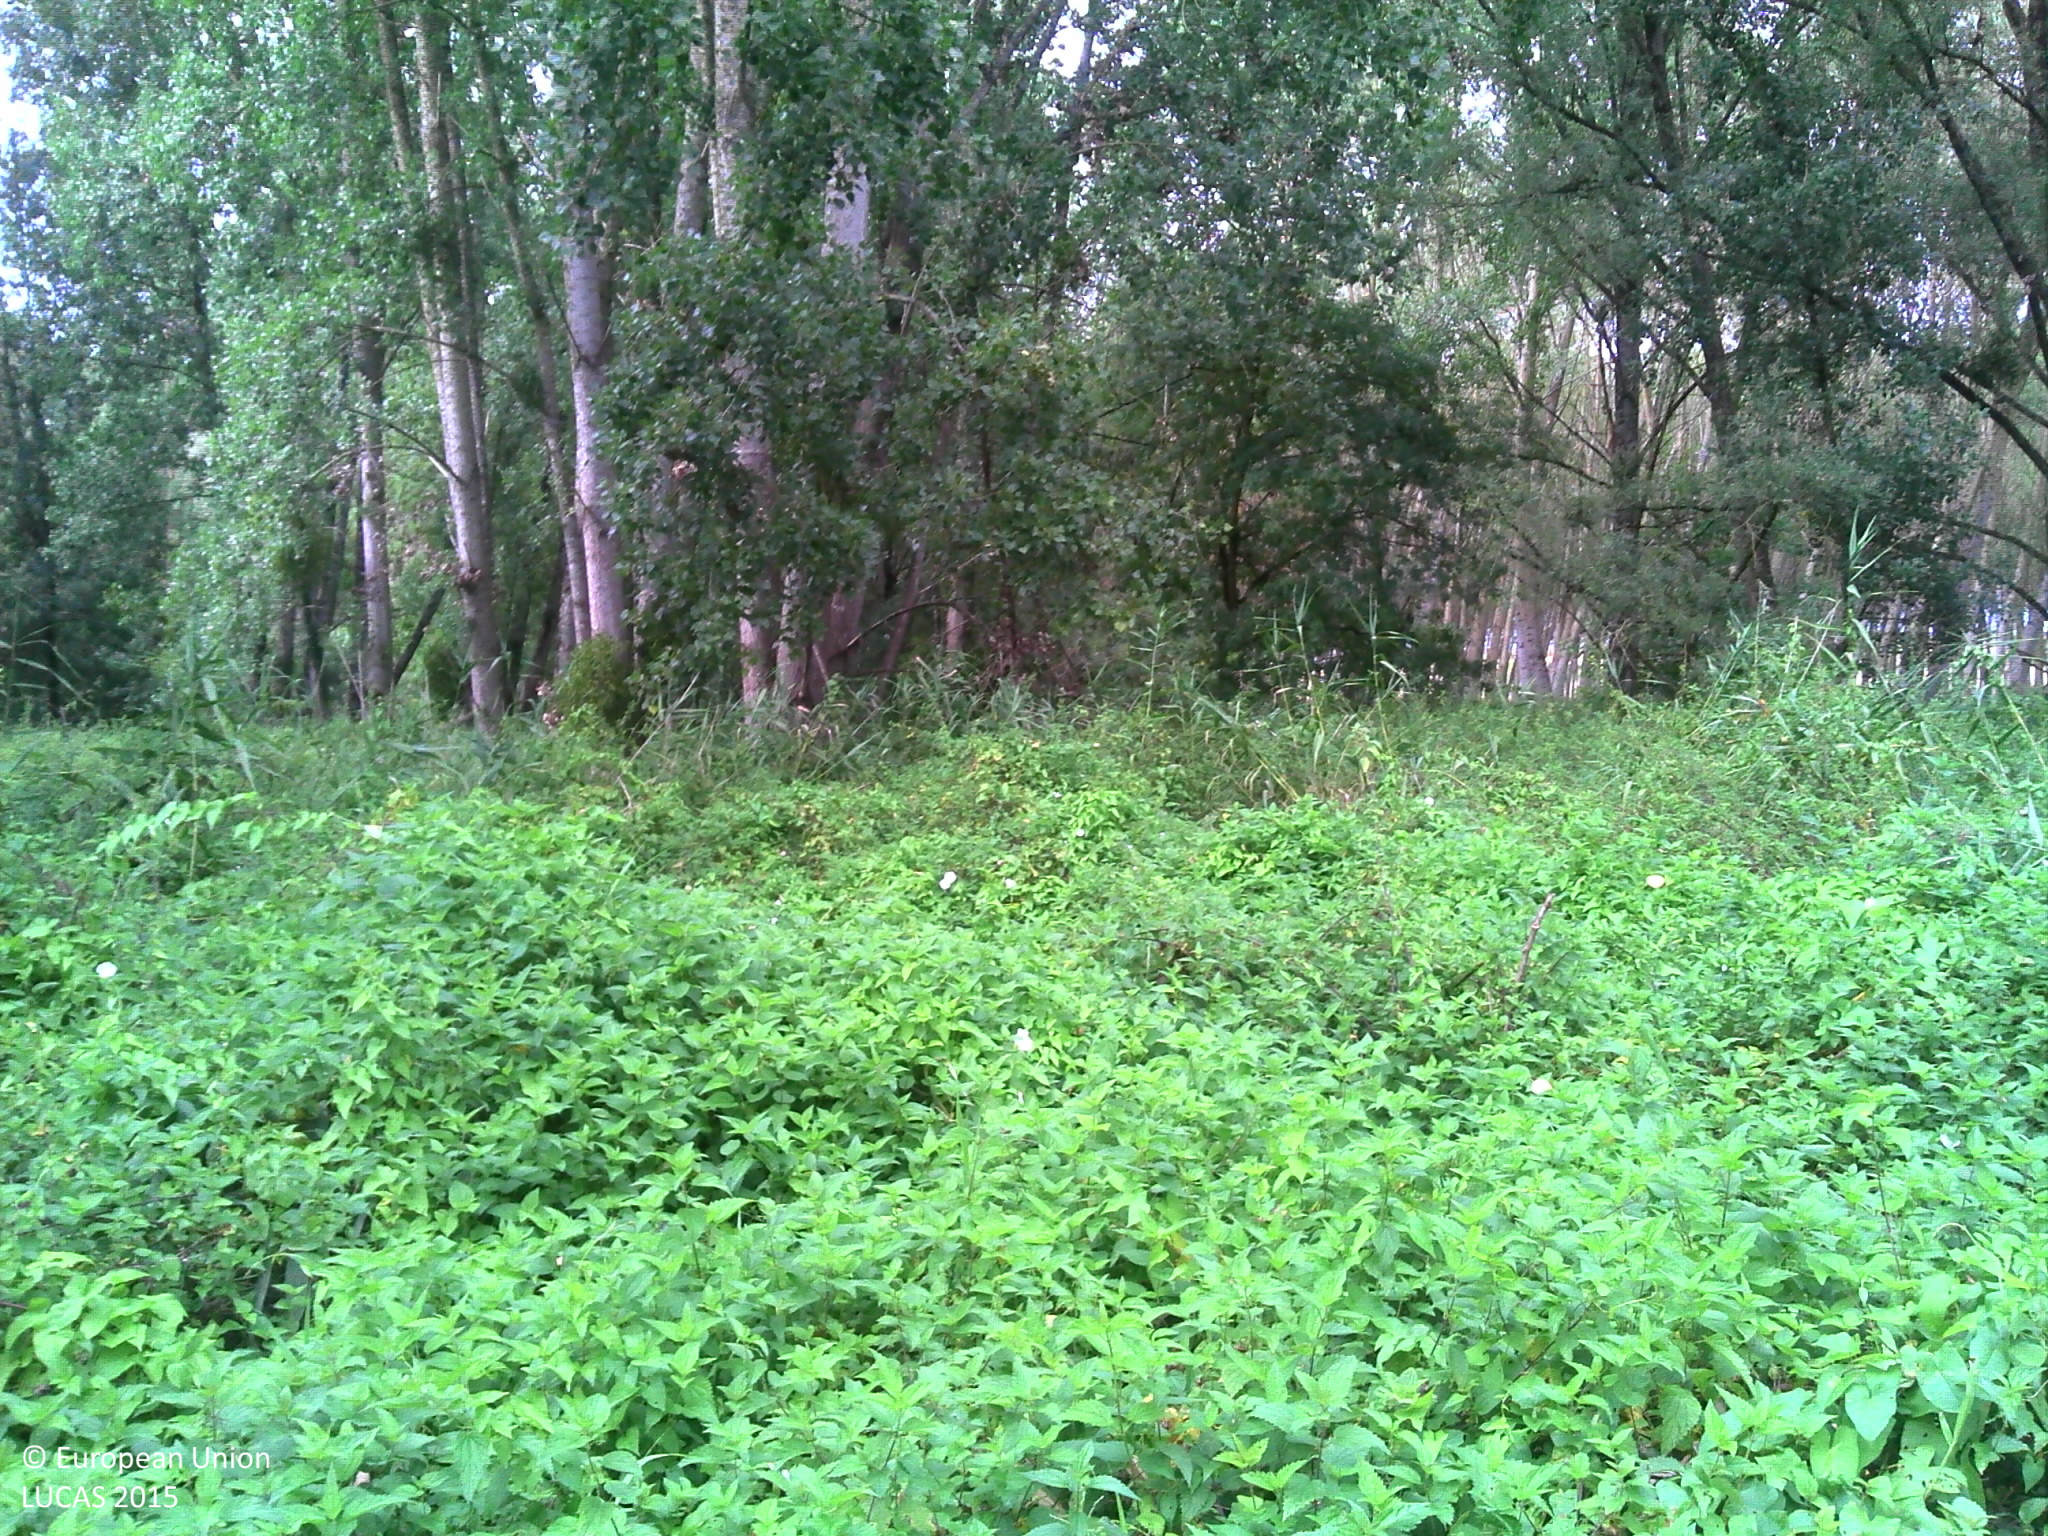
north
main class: Grassland
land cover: Spontaneously vegetated surfaces
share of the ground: > 75 %
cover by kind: herbaceous plants 100 %
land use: Semi-natural and natural areas not in use
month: September
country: FR
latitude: 46.8593
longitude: 1.4490
